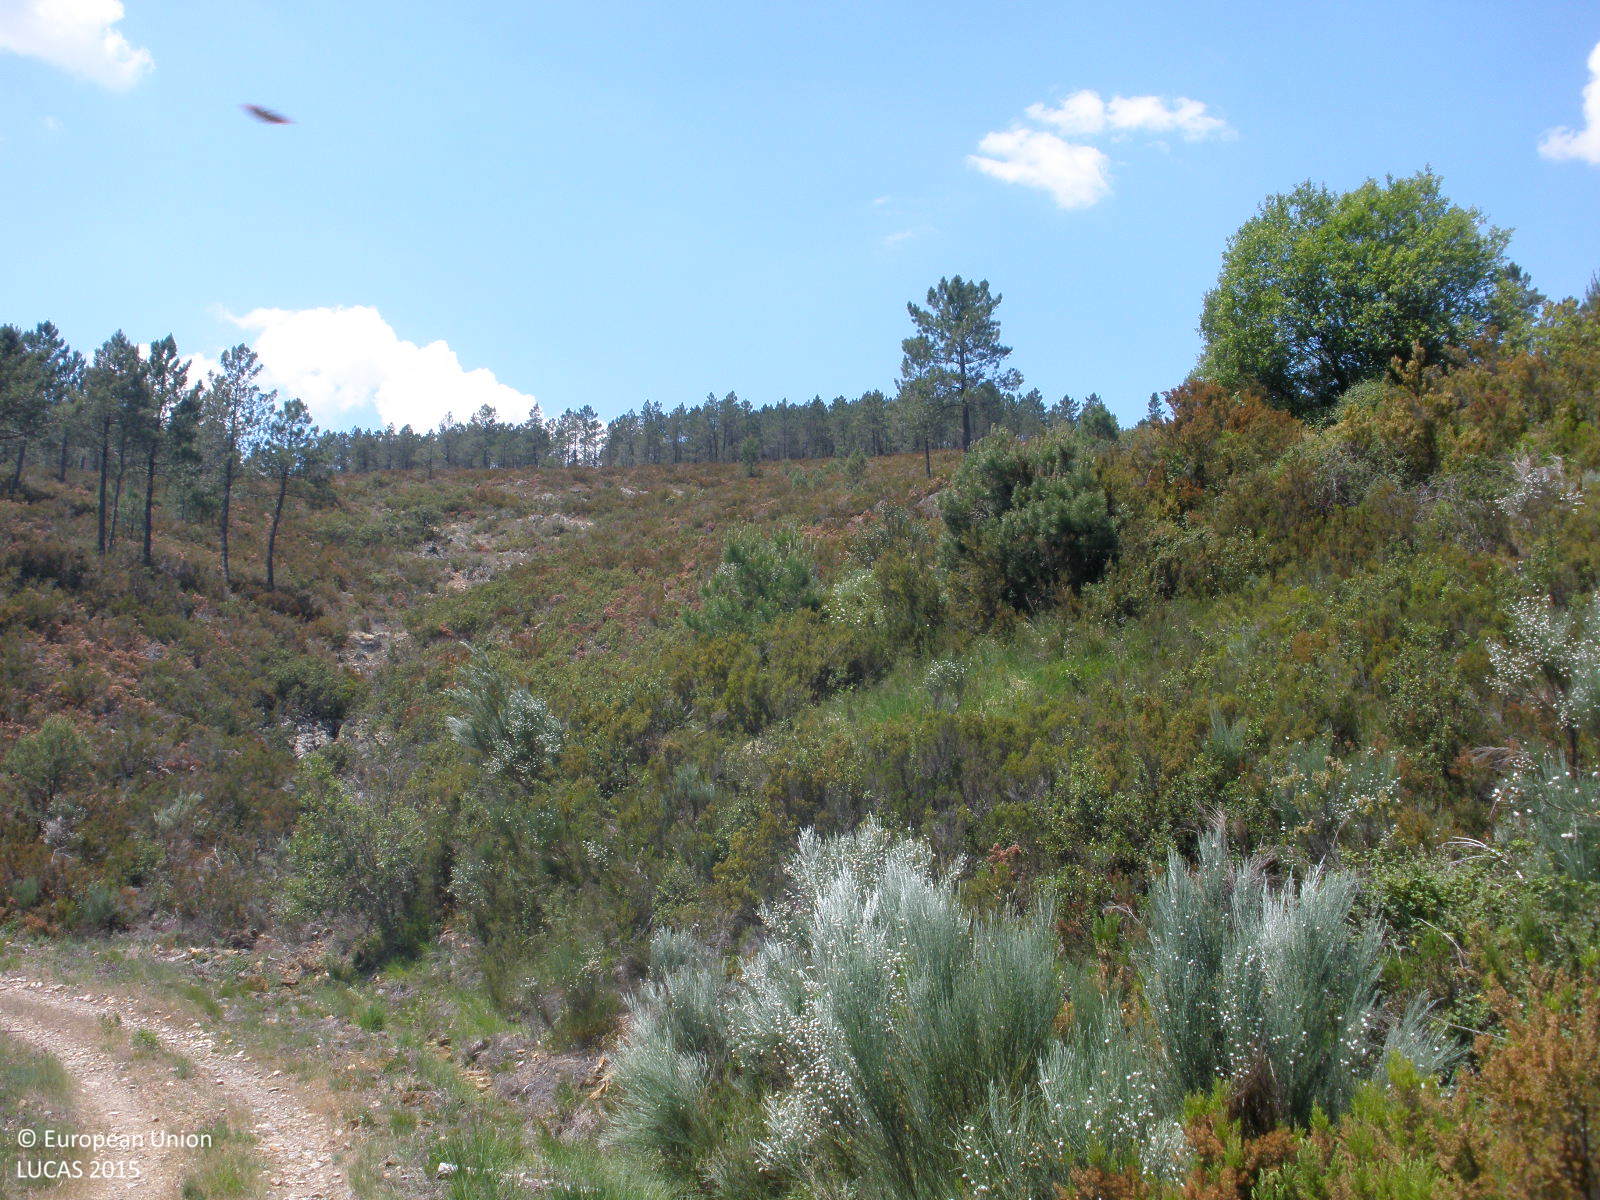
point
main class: Shrubland
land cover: Shrubland with sparse tree cover
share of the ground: > 75 %
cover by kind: shrubs 95 %, coniferous forest trees 5 %
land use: Forestry
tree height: < 5 m
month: June
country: ES
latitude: 40.5059
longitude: -6.2373
